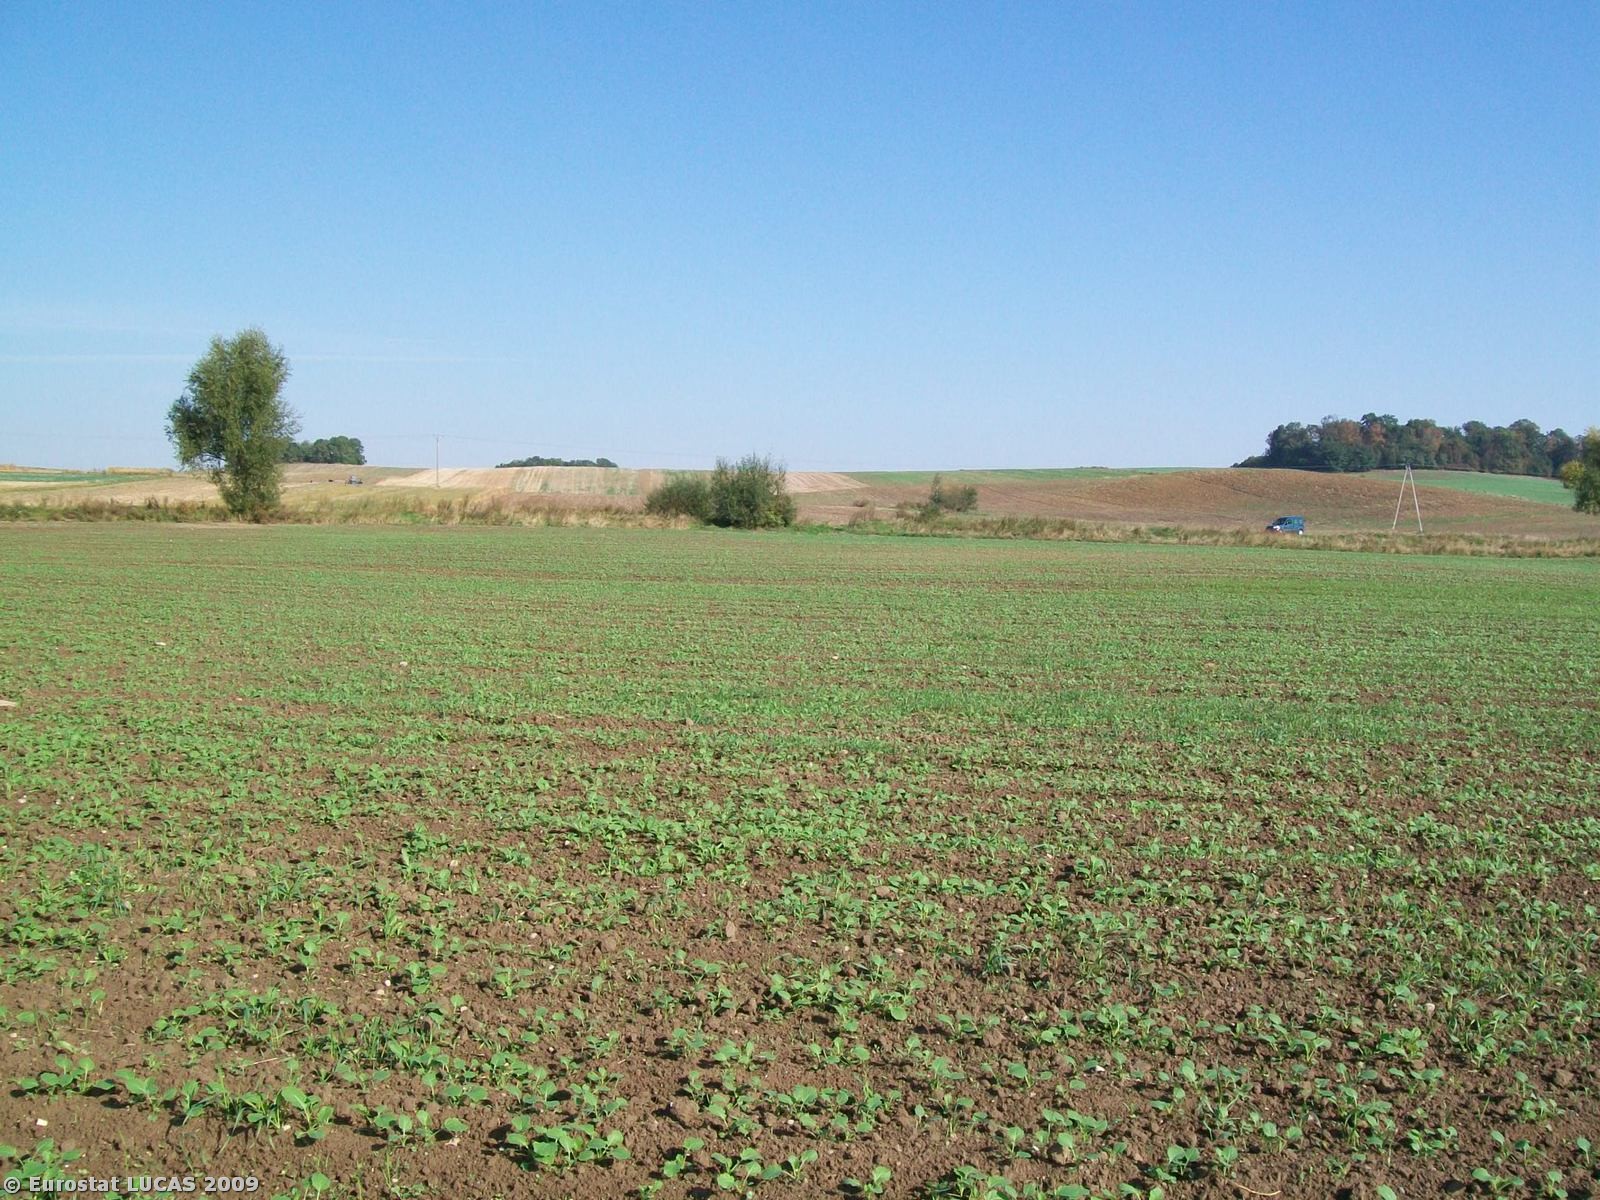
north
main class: Cropland
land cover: Common wheat
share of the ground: < 10 %
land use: Agriculture (excluding fallow land and kitchen gardens)
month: September
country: PL
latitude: 50.4775
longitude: 17.2402
